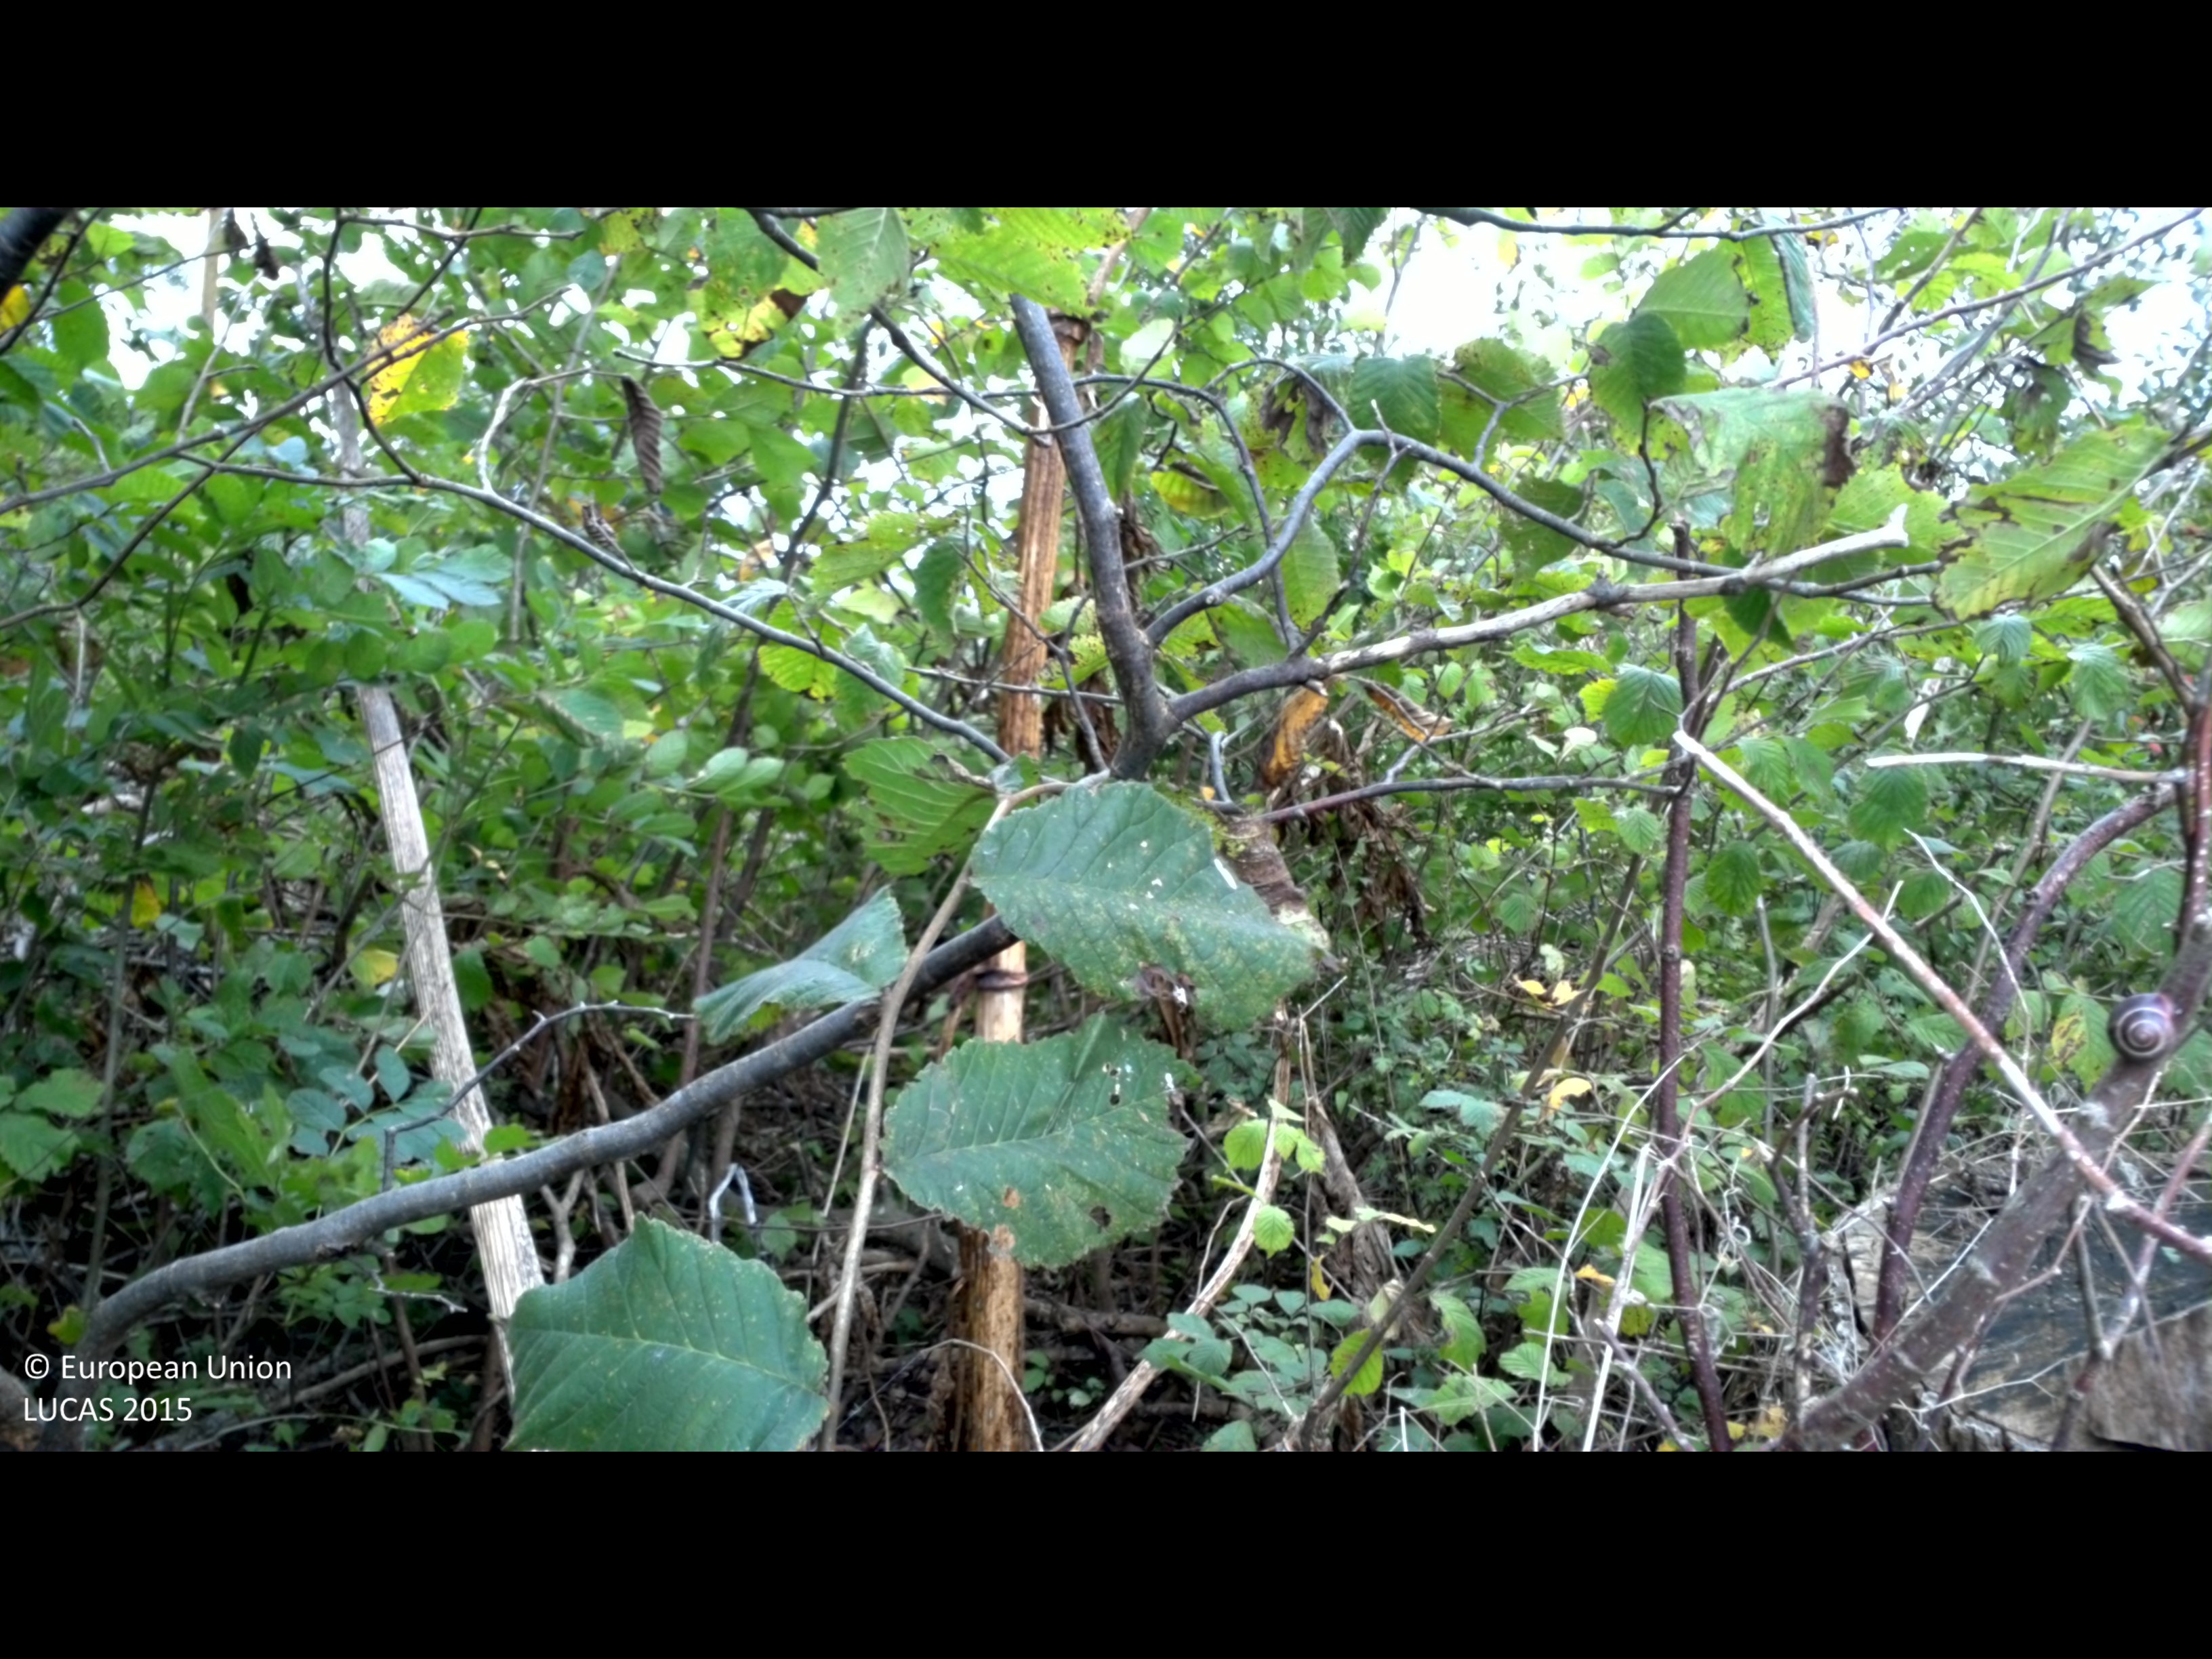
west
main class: Cropland
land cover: Potatoes
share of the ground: > 75 %
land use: Agriculture (excluding fallow land and kitchen gardens)
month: September
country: SE
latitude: 56.0506
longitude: 14.0921
